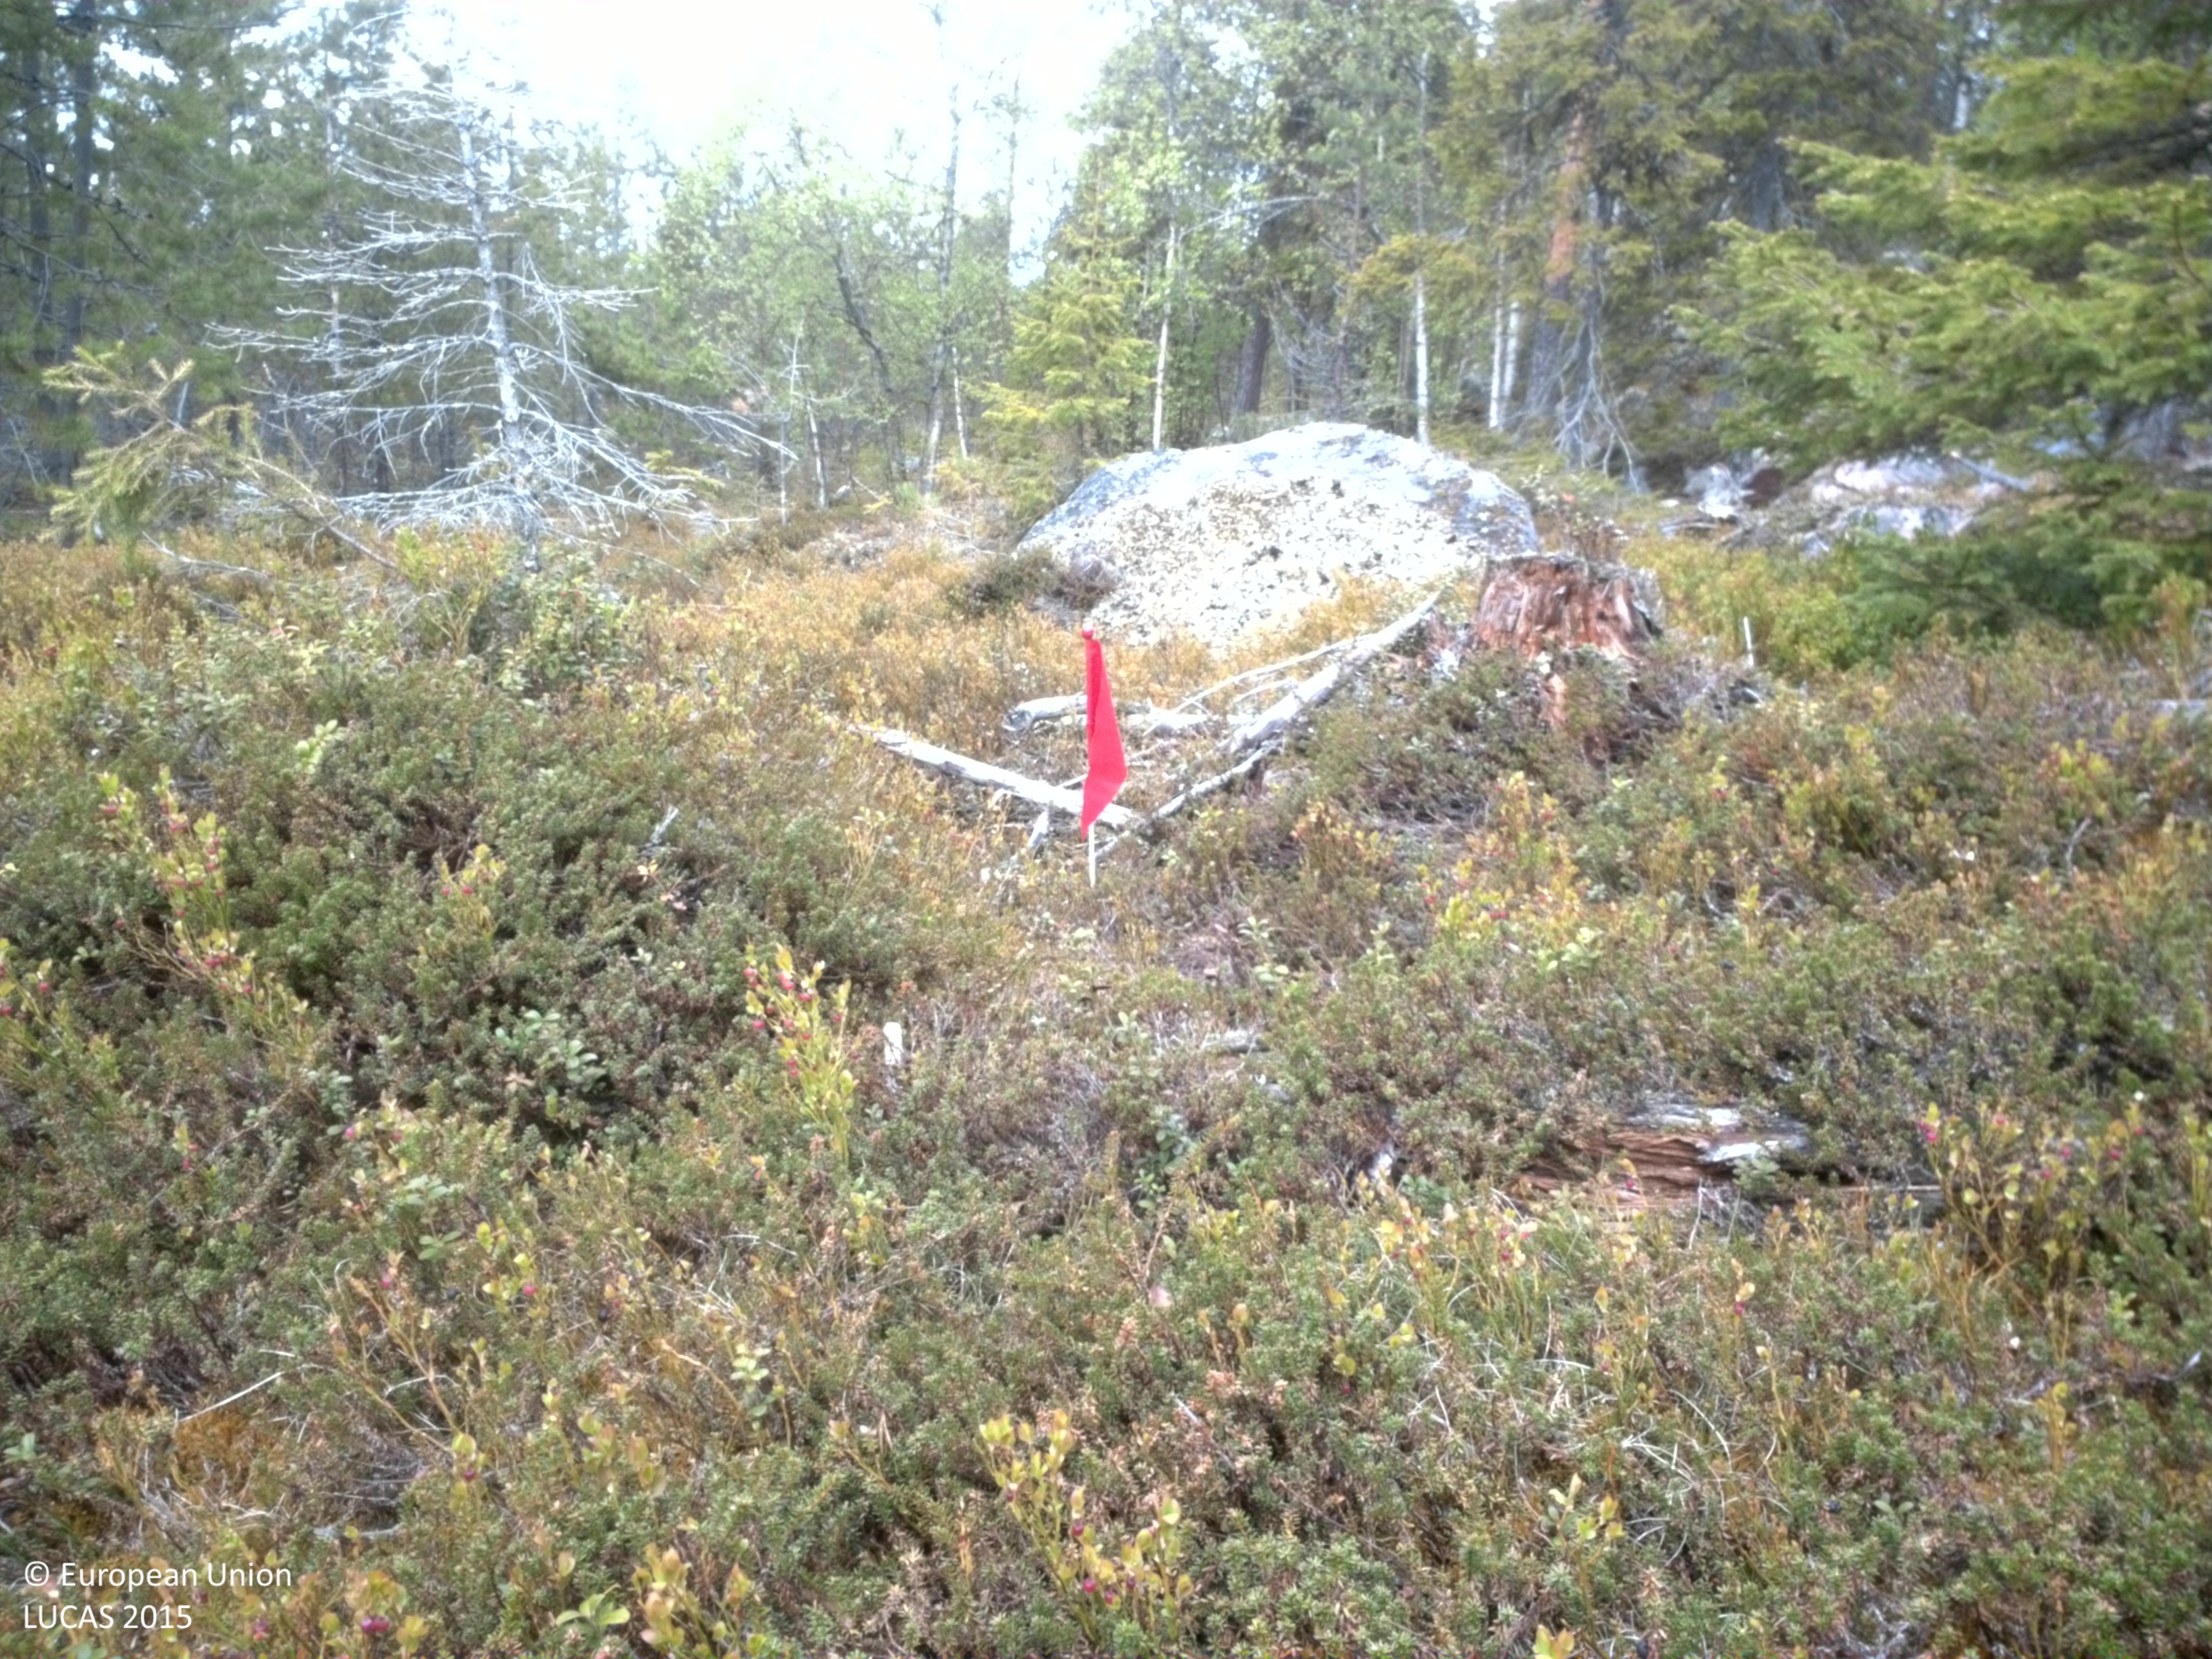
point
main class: Woodland
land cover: Spruce dominated coniferous woodland
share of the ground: 10 - 25 %
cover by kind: herbaceous plants 75 %, coniferous forest trees 10 %, lichens and mosses 10 %, shrubs 5 %
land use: Forestry
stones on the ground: < 10 %
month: June
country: SE
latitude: 66.7877
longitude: 22.4496
